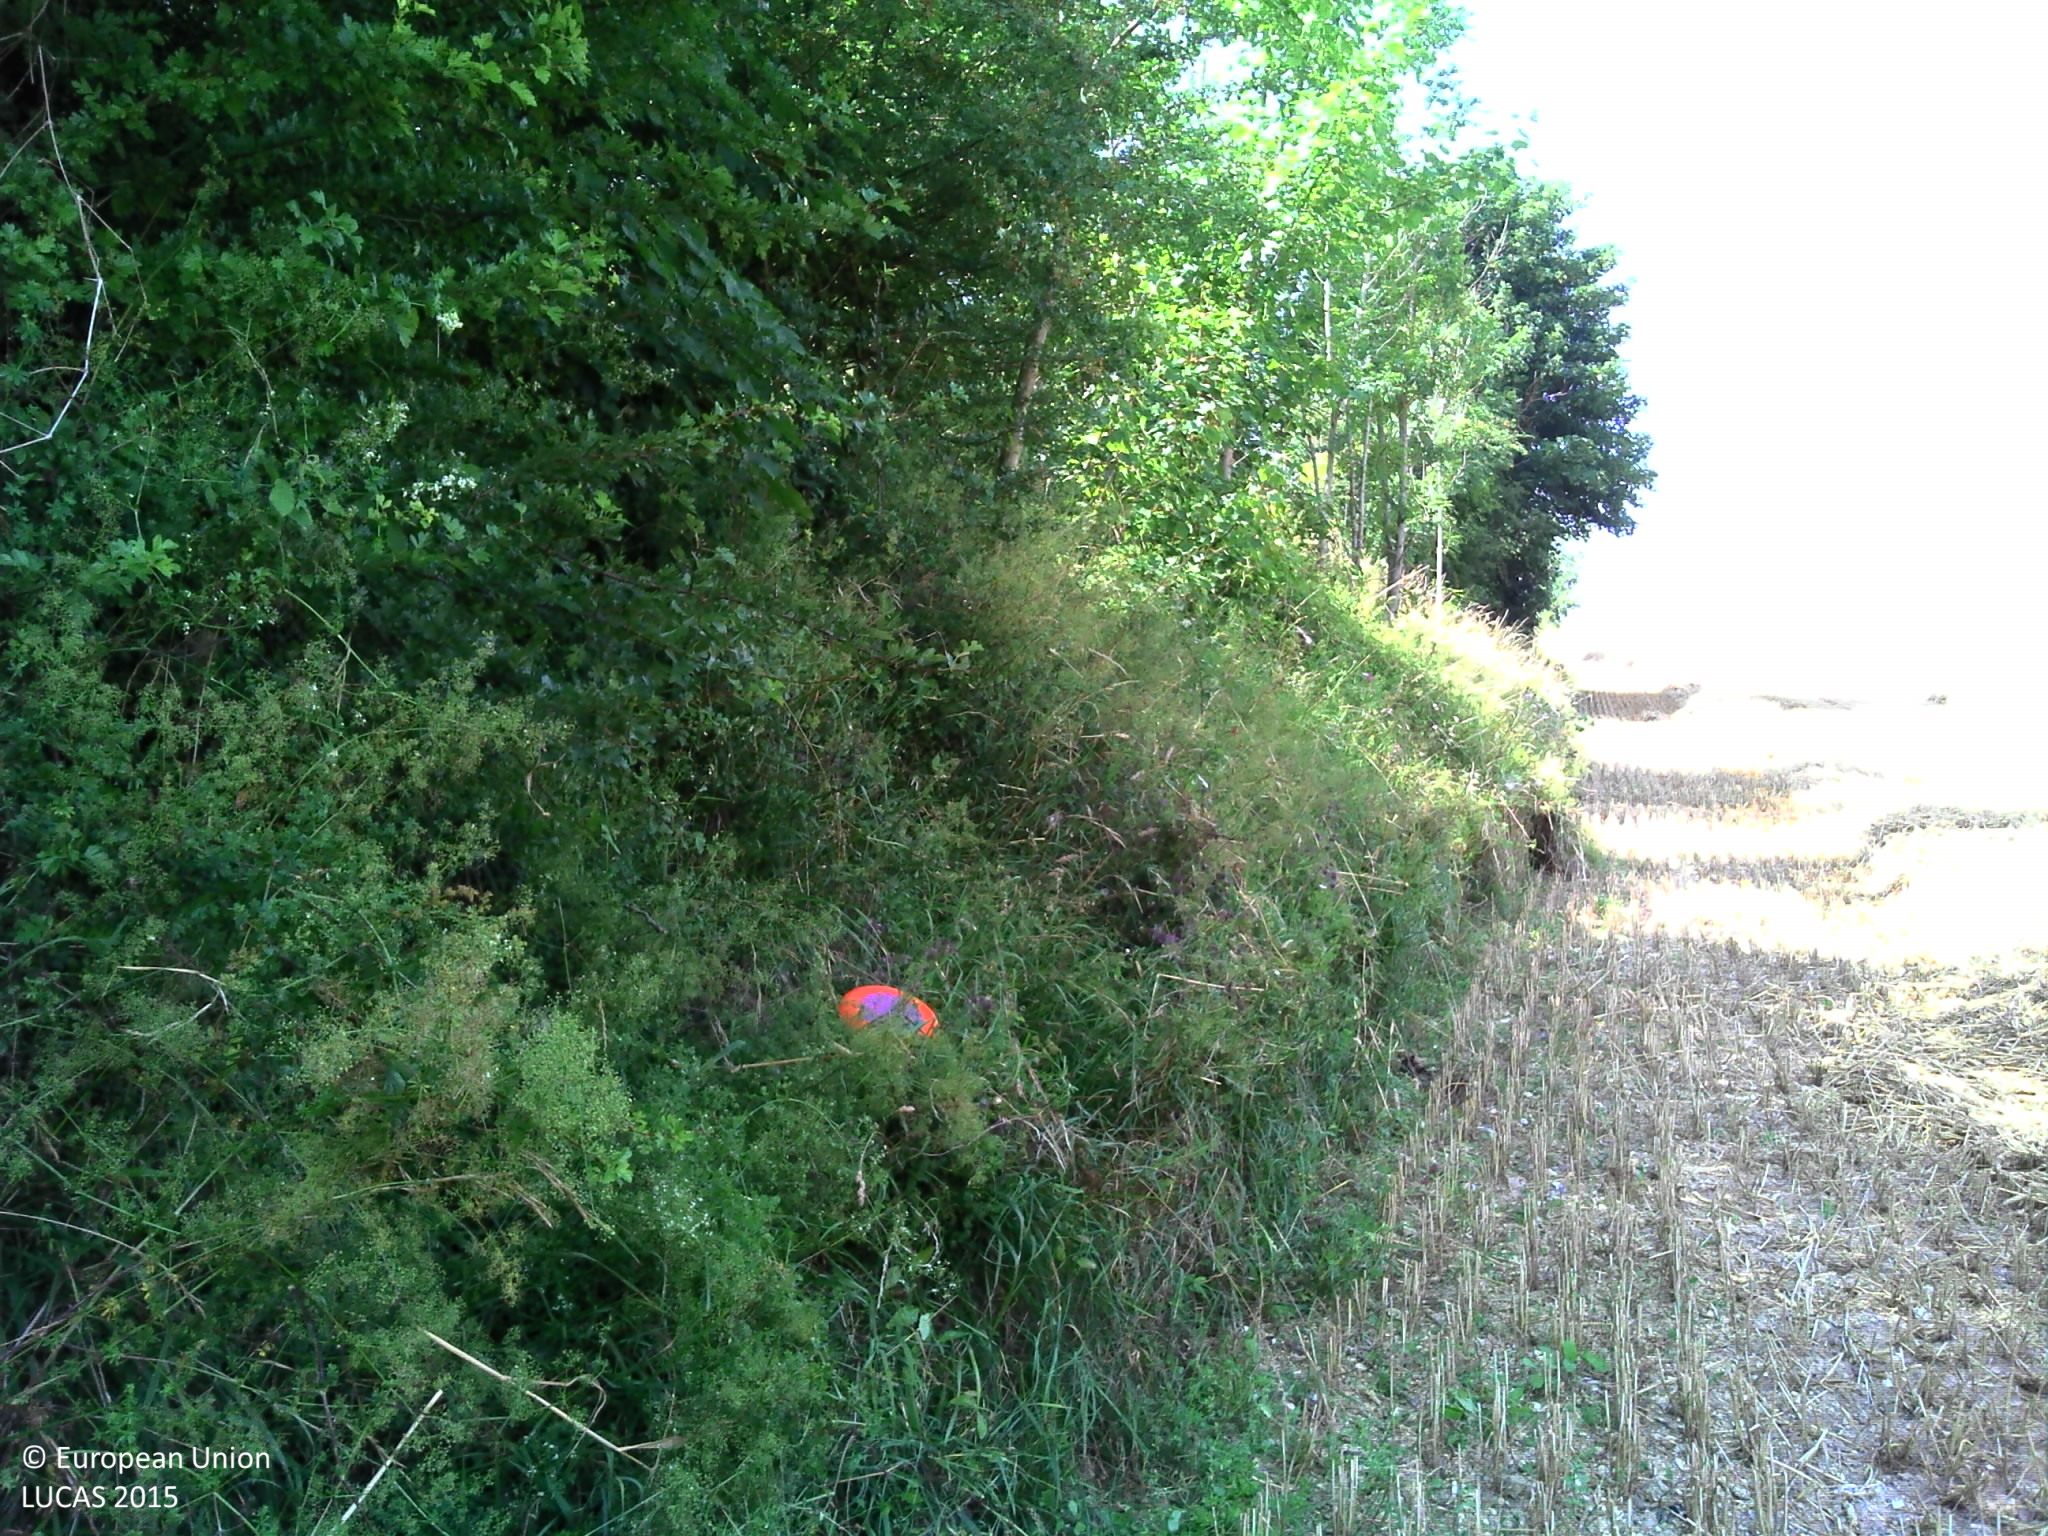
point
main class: Cropland
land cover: Common wheat
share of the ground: > 75 %
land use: Agriculture (excluding fallow land and kitchen gardens)
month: August
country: FR
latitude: 50.8080
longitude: 2.0231
